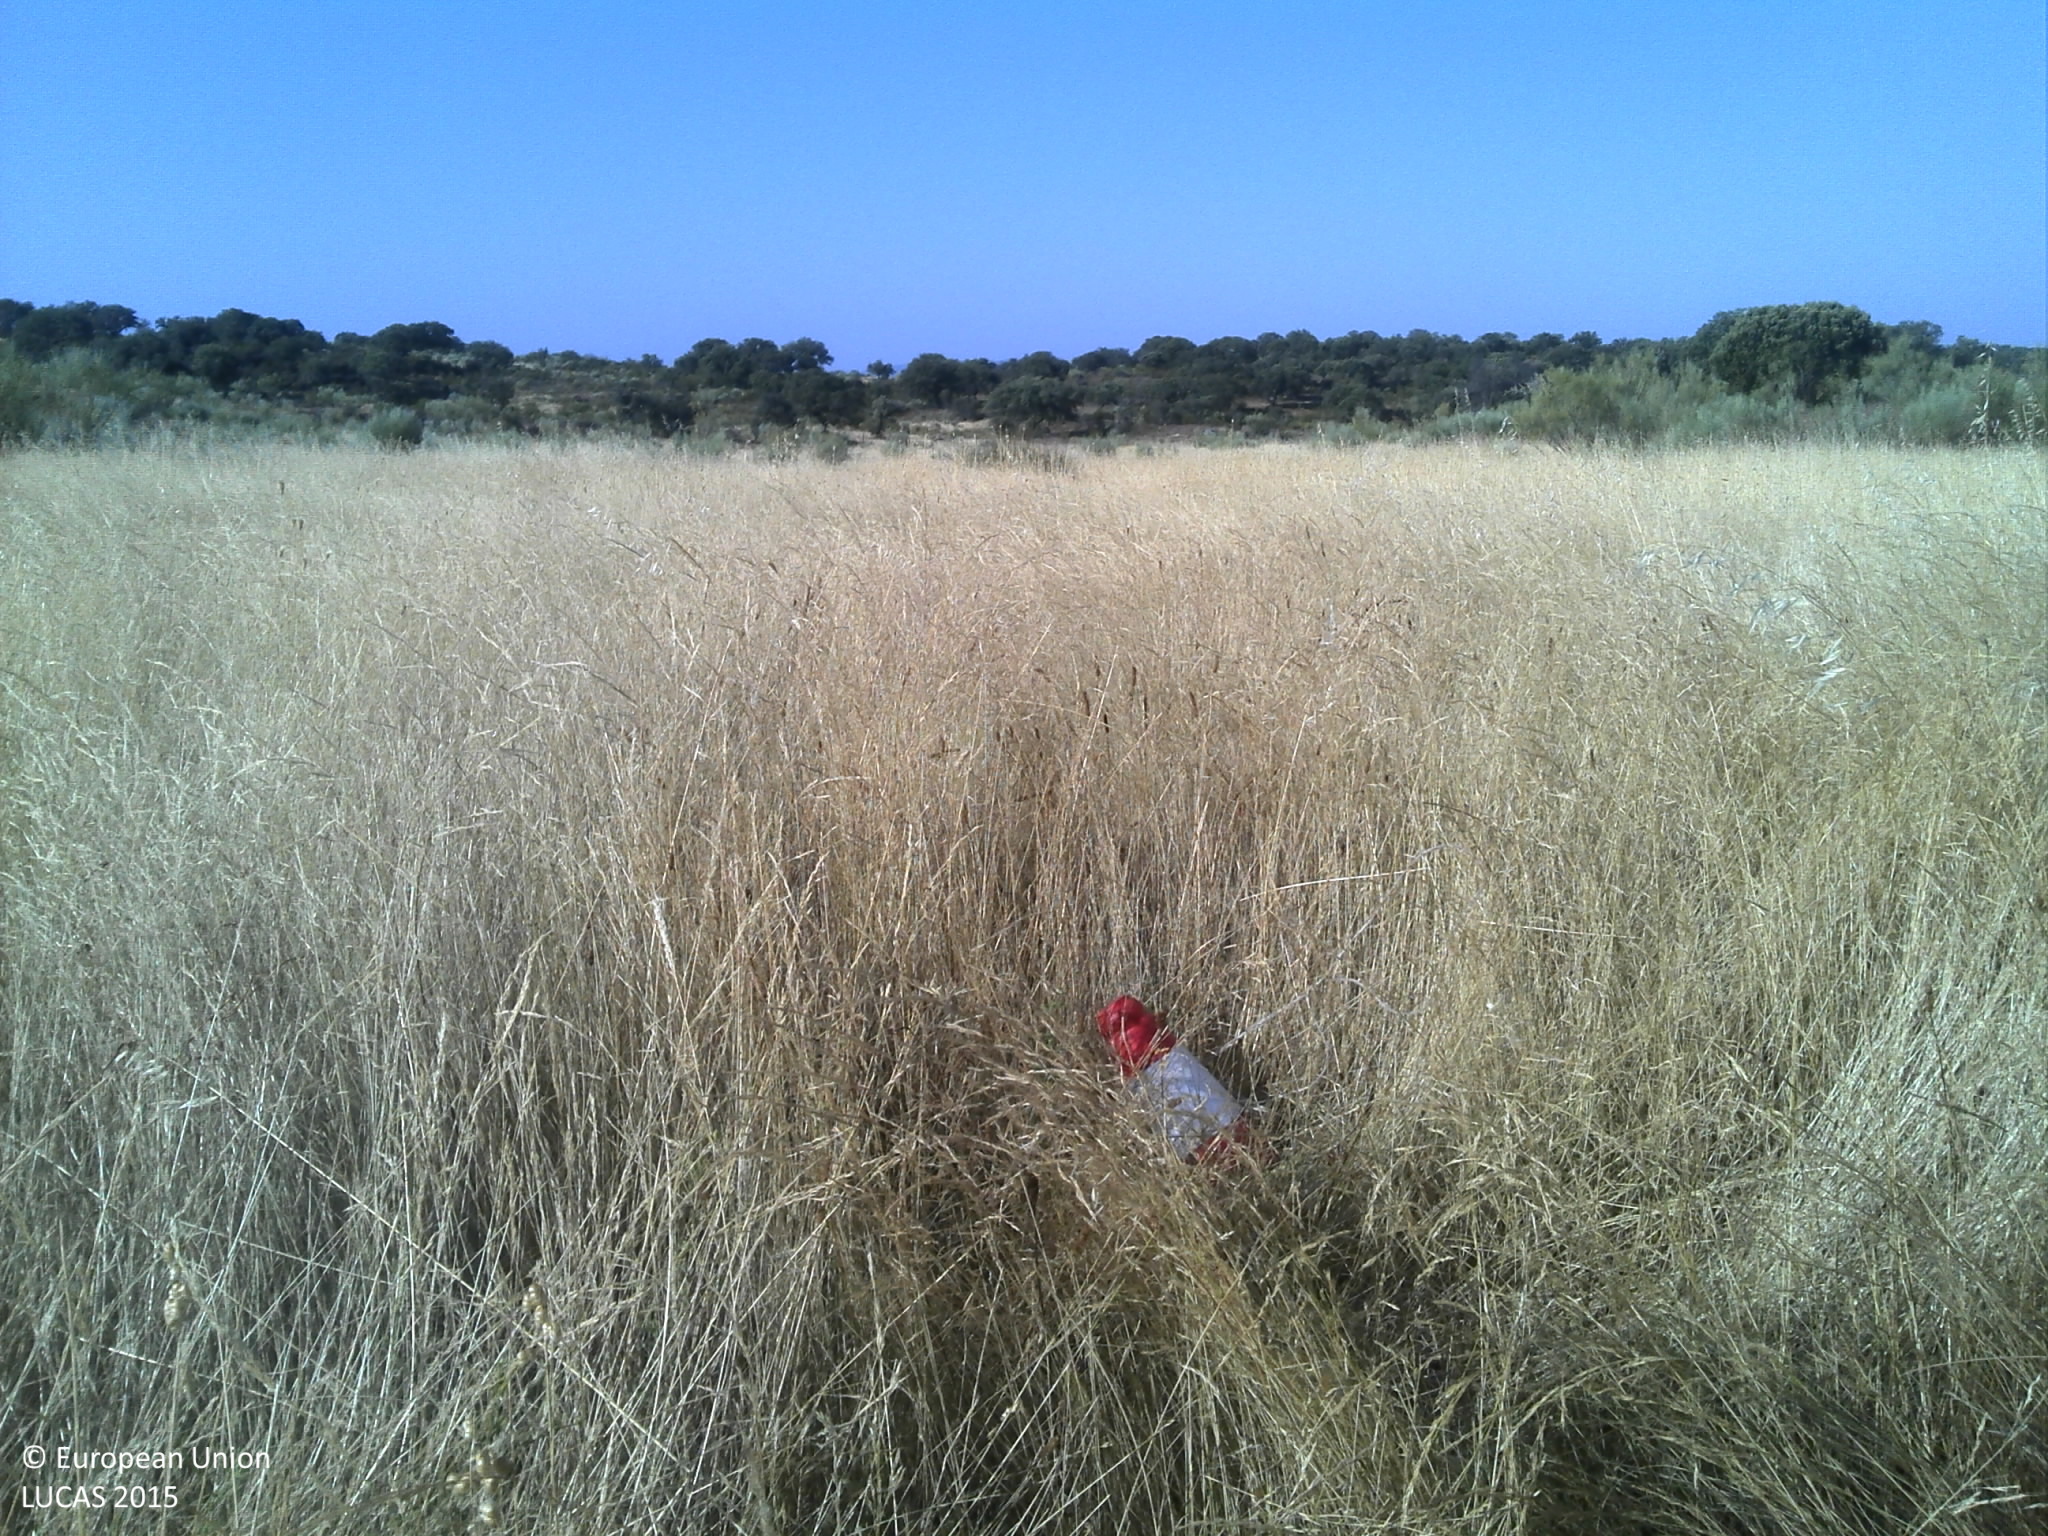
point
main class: Grassland
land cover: Grassland without tree/shrub cover
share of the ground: 50 - 75 %
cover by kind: herbaceous plants 65 %, unconsolidated bare surface 25 %, shrubs 5 %
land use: Agriculture (excluding fallow land and kitchen gardens)
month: June
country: PT
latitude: 39.7155
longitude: -7.0834
